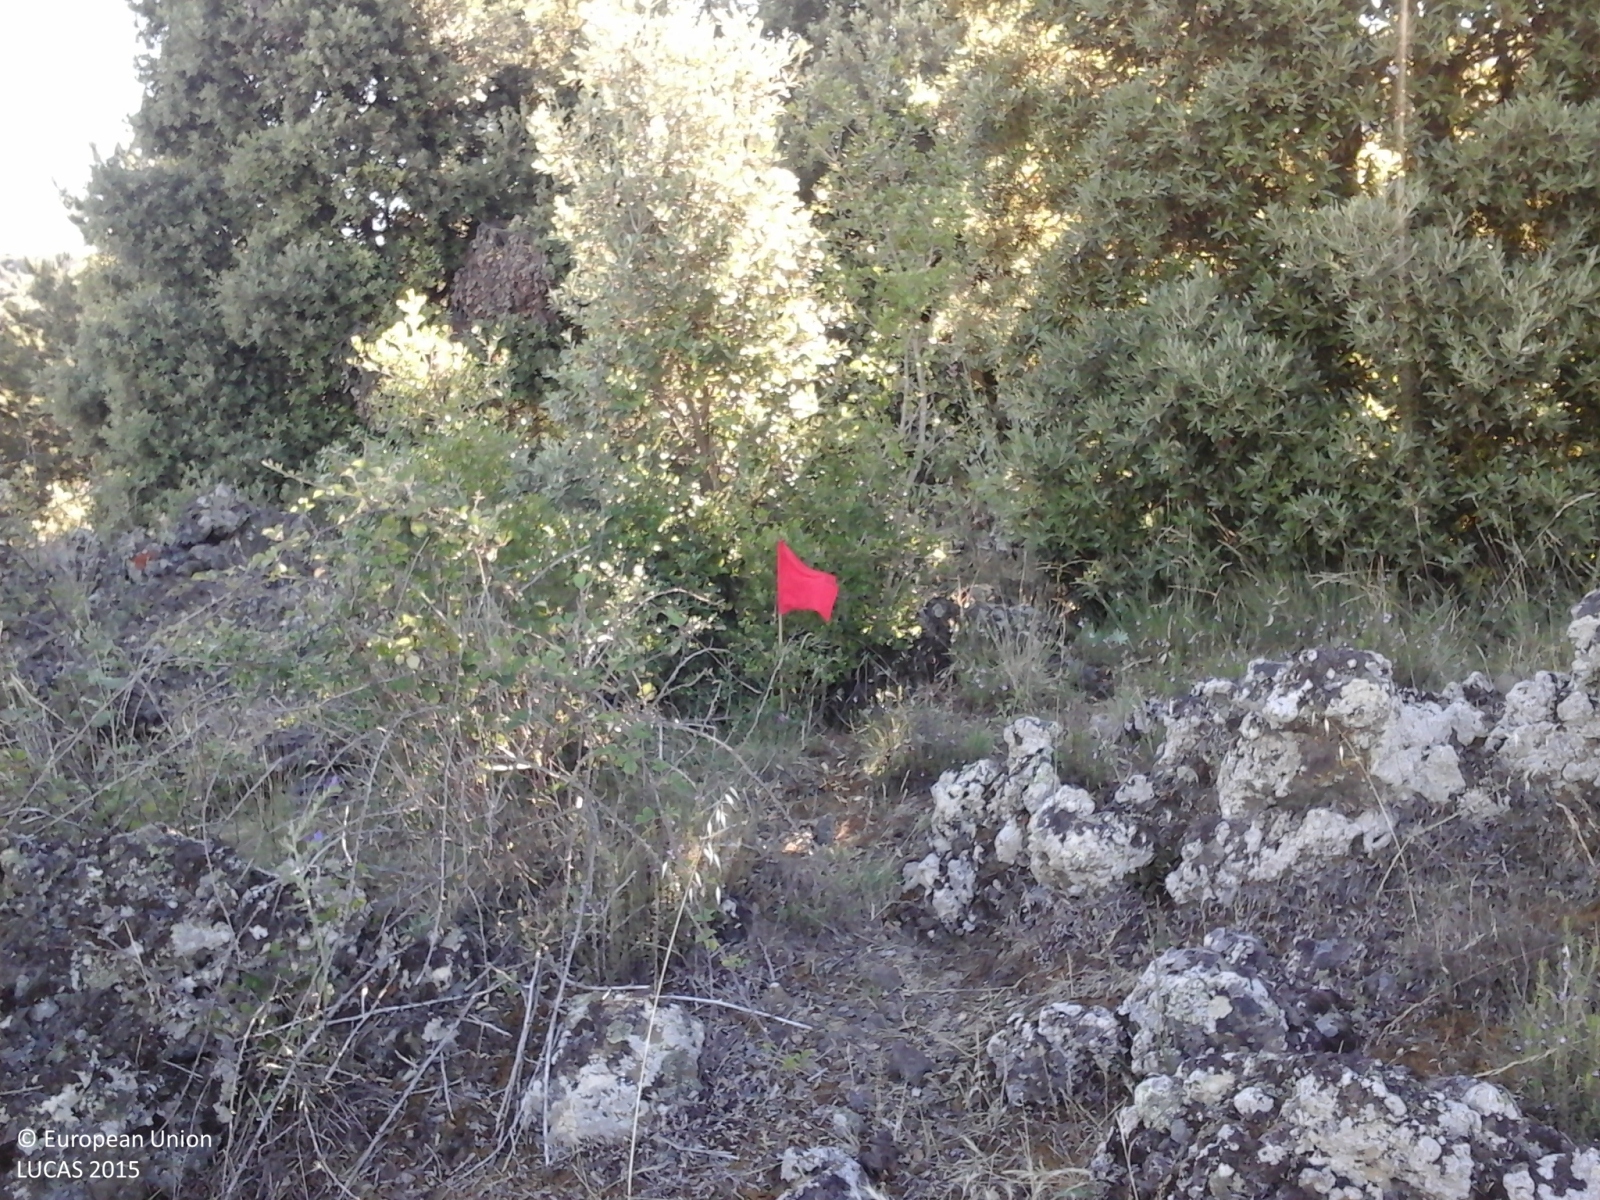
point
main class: Woodland
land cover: Broadleaved woodland
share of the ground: > 75 %
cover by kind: broadleaved forest trees 60 %, shrubs 20 %, coniferous forest trees 10 %, herbaceous plants 5 %, unconsolidated bare surface 5 %
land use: Amenities, museums, leisure
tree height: < 5 m
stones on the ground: > 50 %
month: June
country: IT
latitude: 37.7325
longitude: 14.8565
